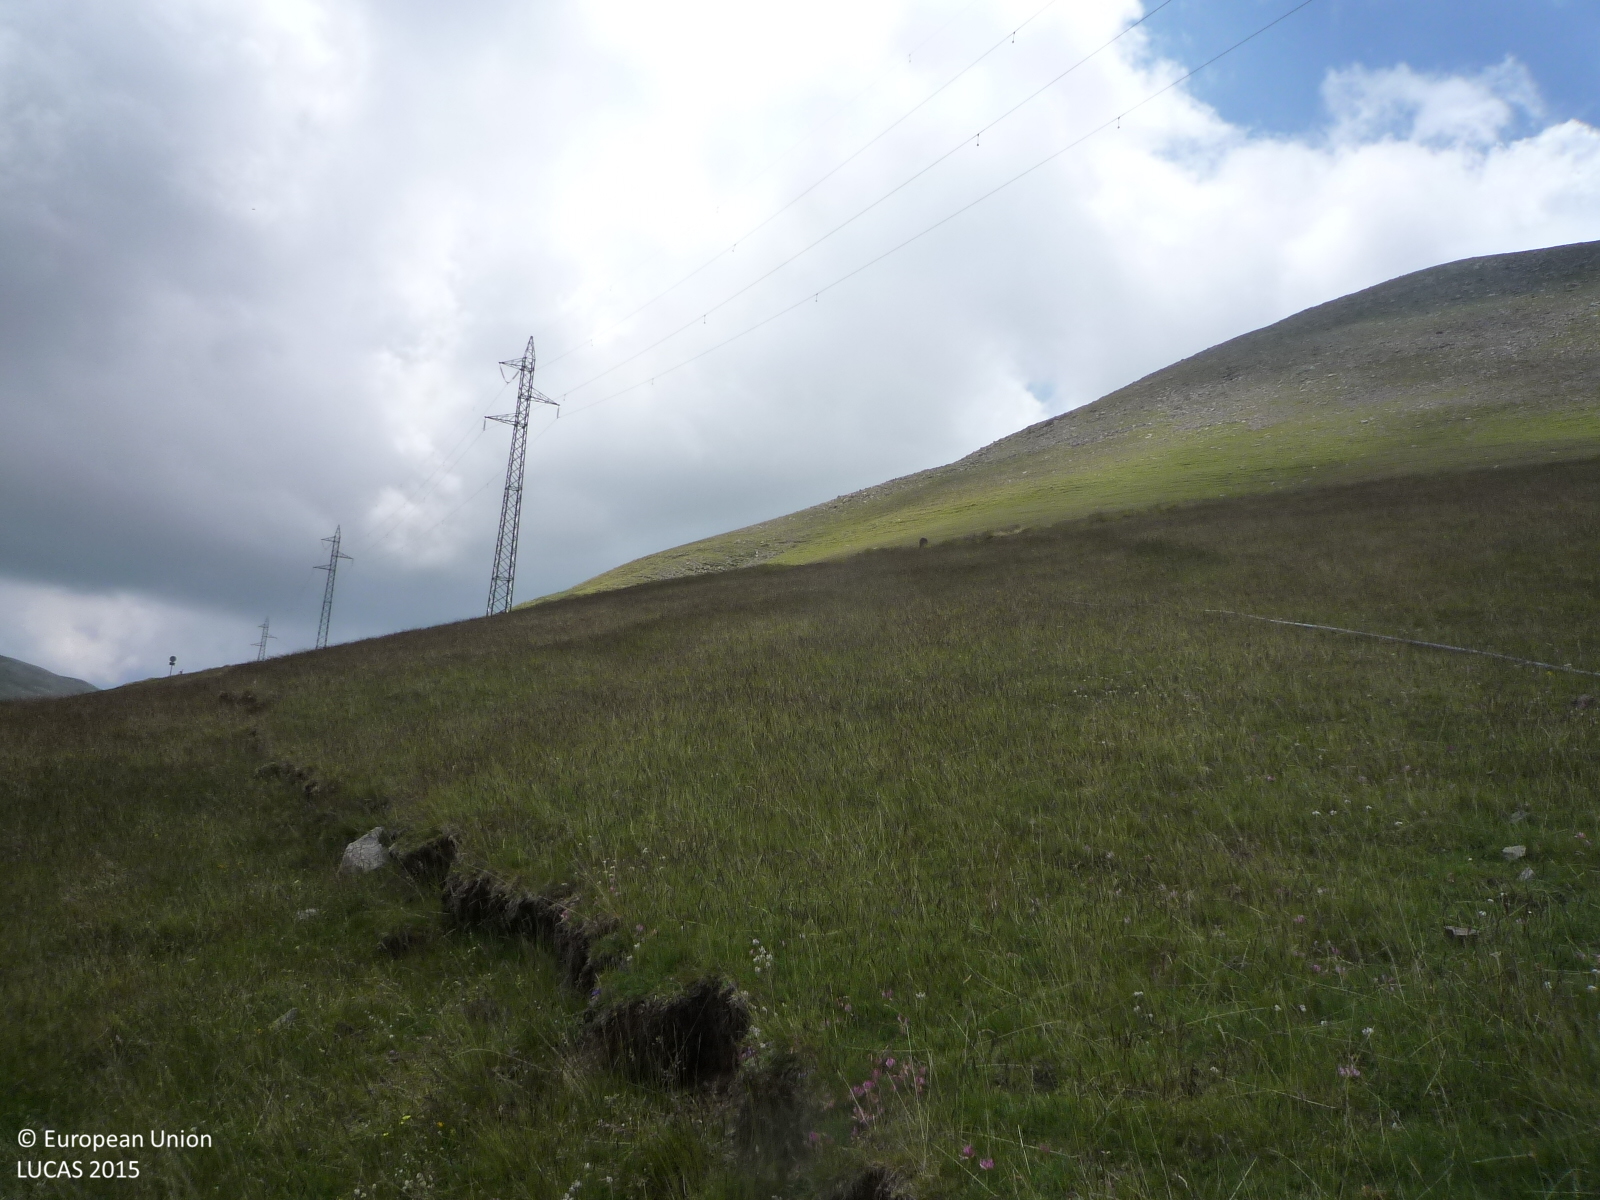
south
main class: Grassland
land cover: Grassland without tree/shrub cover
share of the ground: > 75 %
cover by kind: herbaceous plants 100 %
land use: Agriculture (excluding fallow land and kitchen gardens)
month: June
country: ES
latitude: 42.3126
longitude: 1.9195
